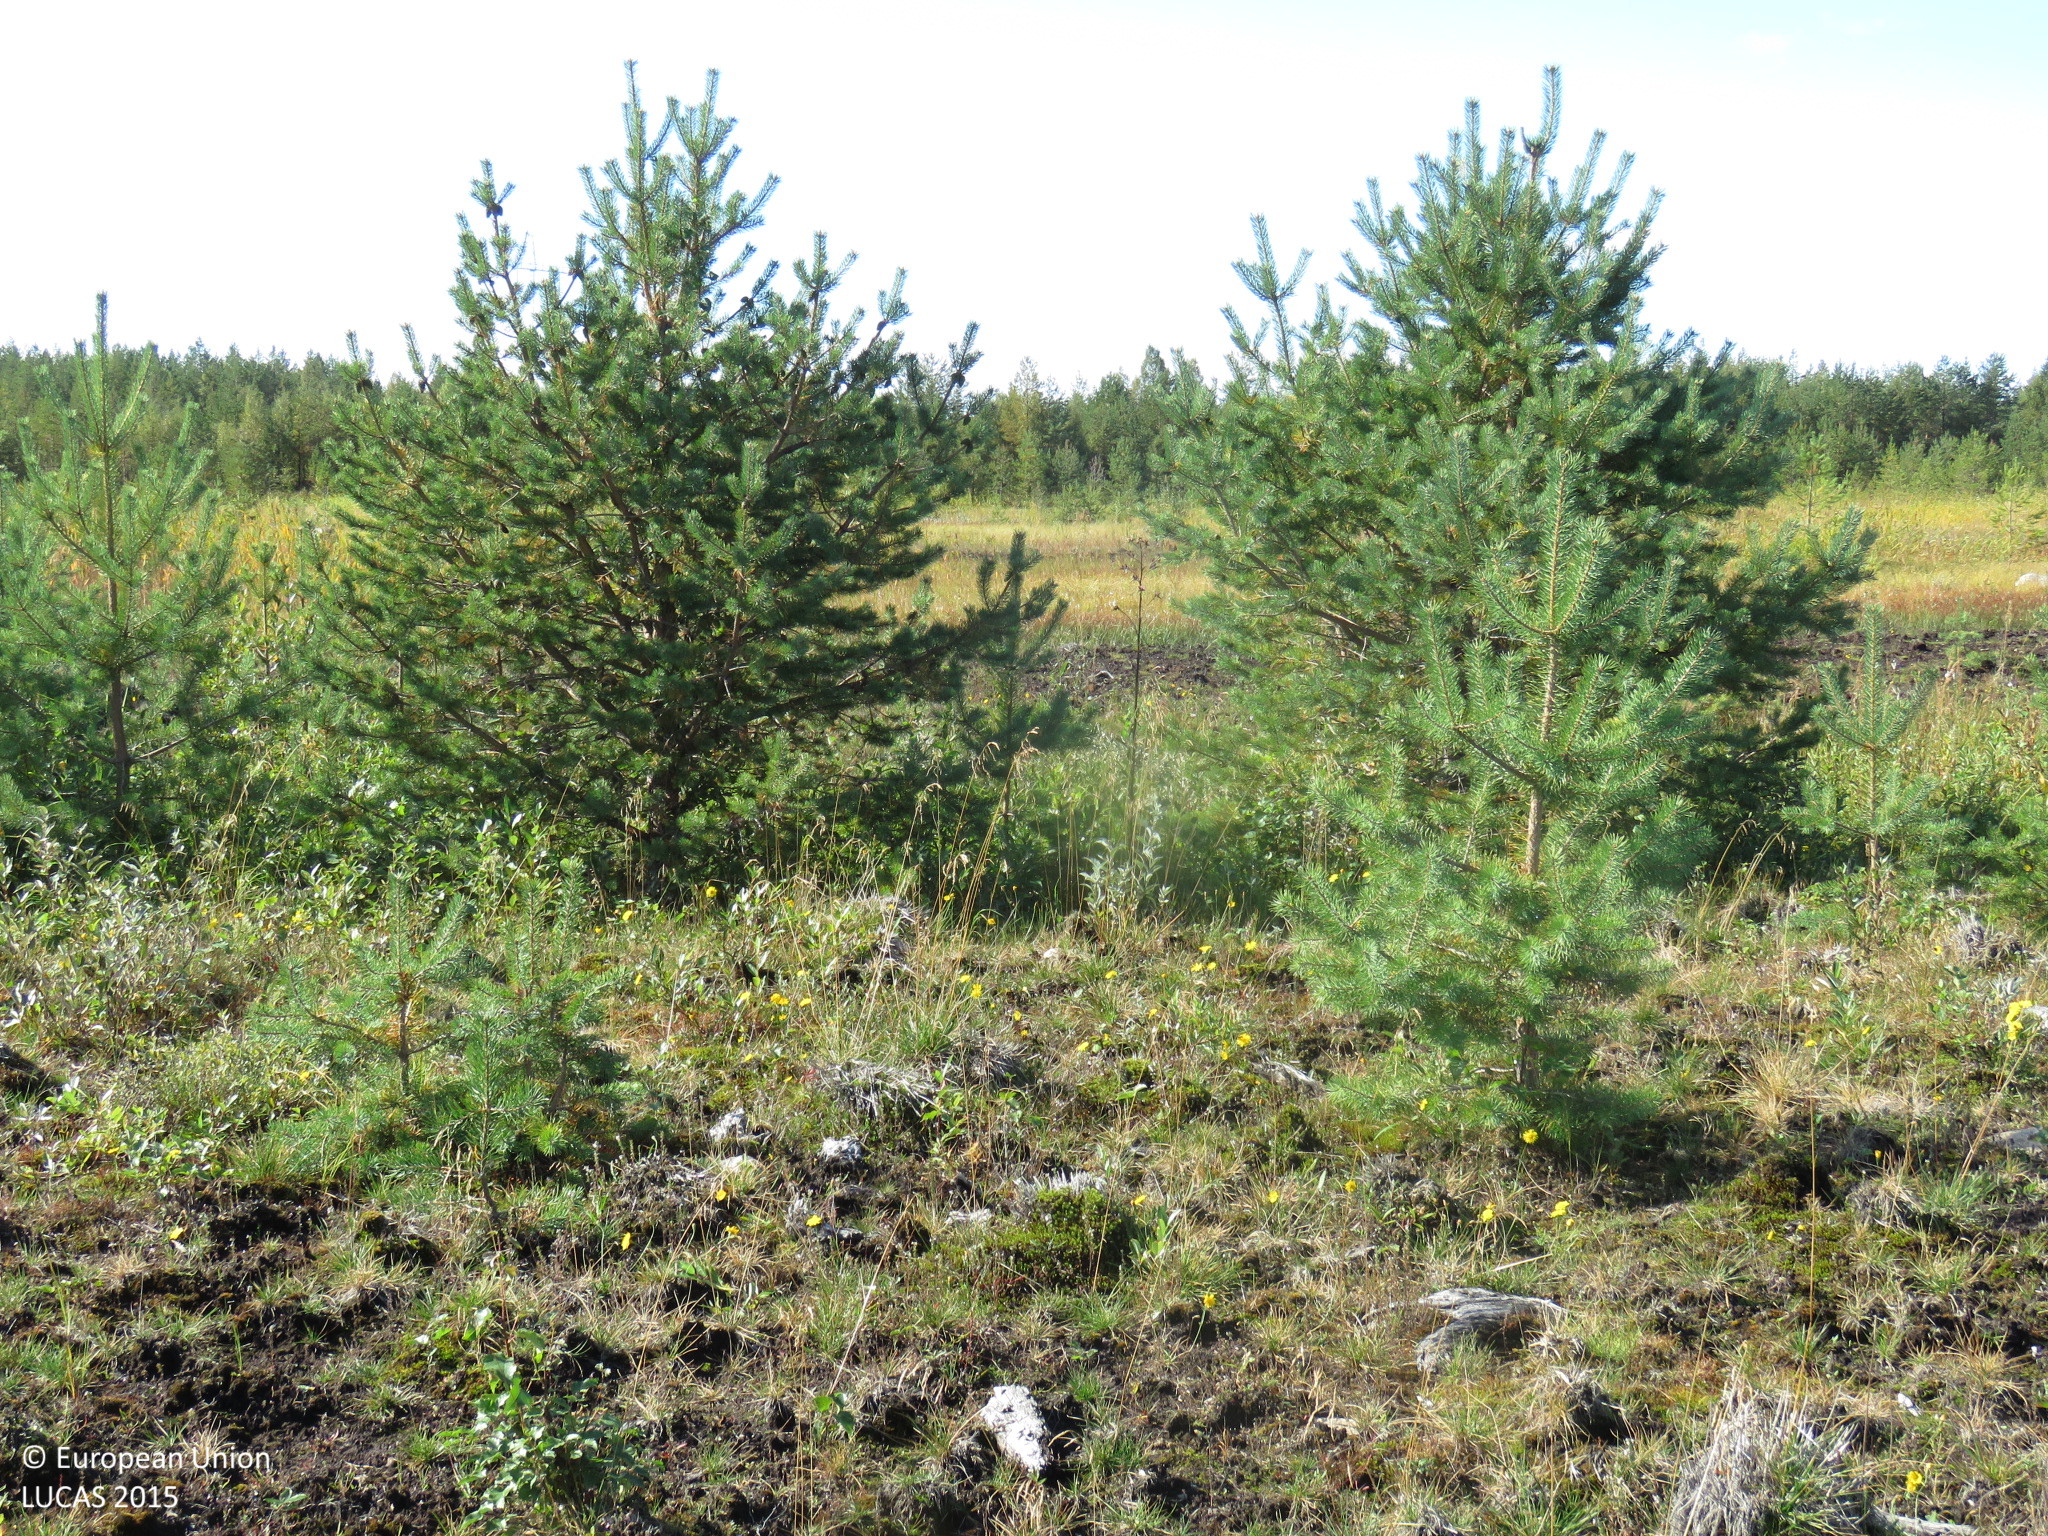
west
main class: Woodland
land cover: Pine dominated mixed woodland
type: mire and swamp forests
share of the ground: 10 - 25 %
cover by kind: unconsolidated bare surface 50 %, herbaceous plants 30 %, coniferous forest trees 10 %, broadleaved forest trees 5 %, lichens and mosses 5 %
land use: Abandoned areas
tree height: < 5 m
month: August
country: FI
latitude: 65.2770
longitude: 26.0576
